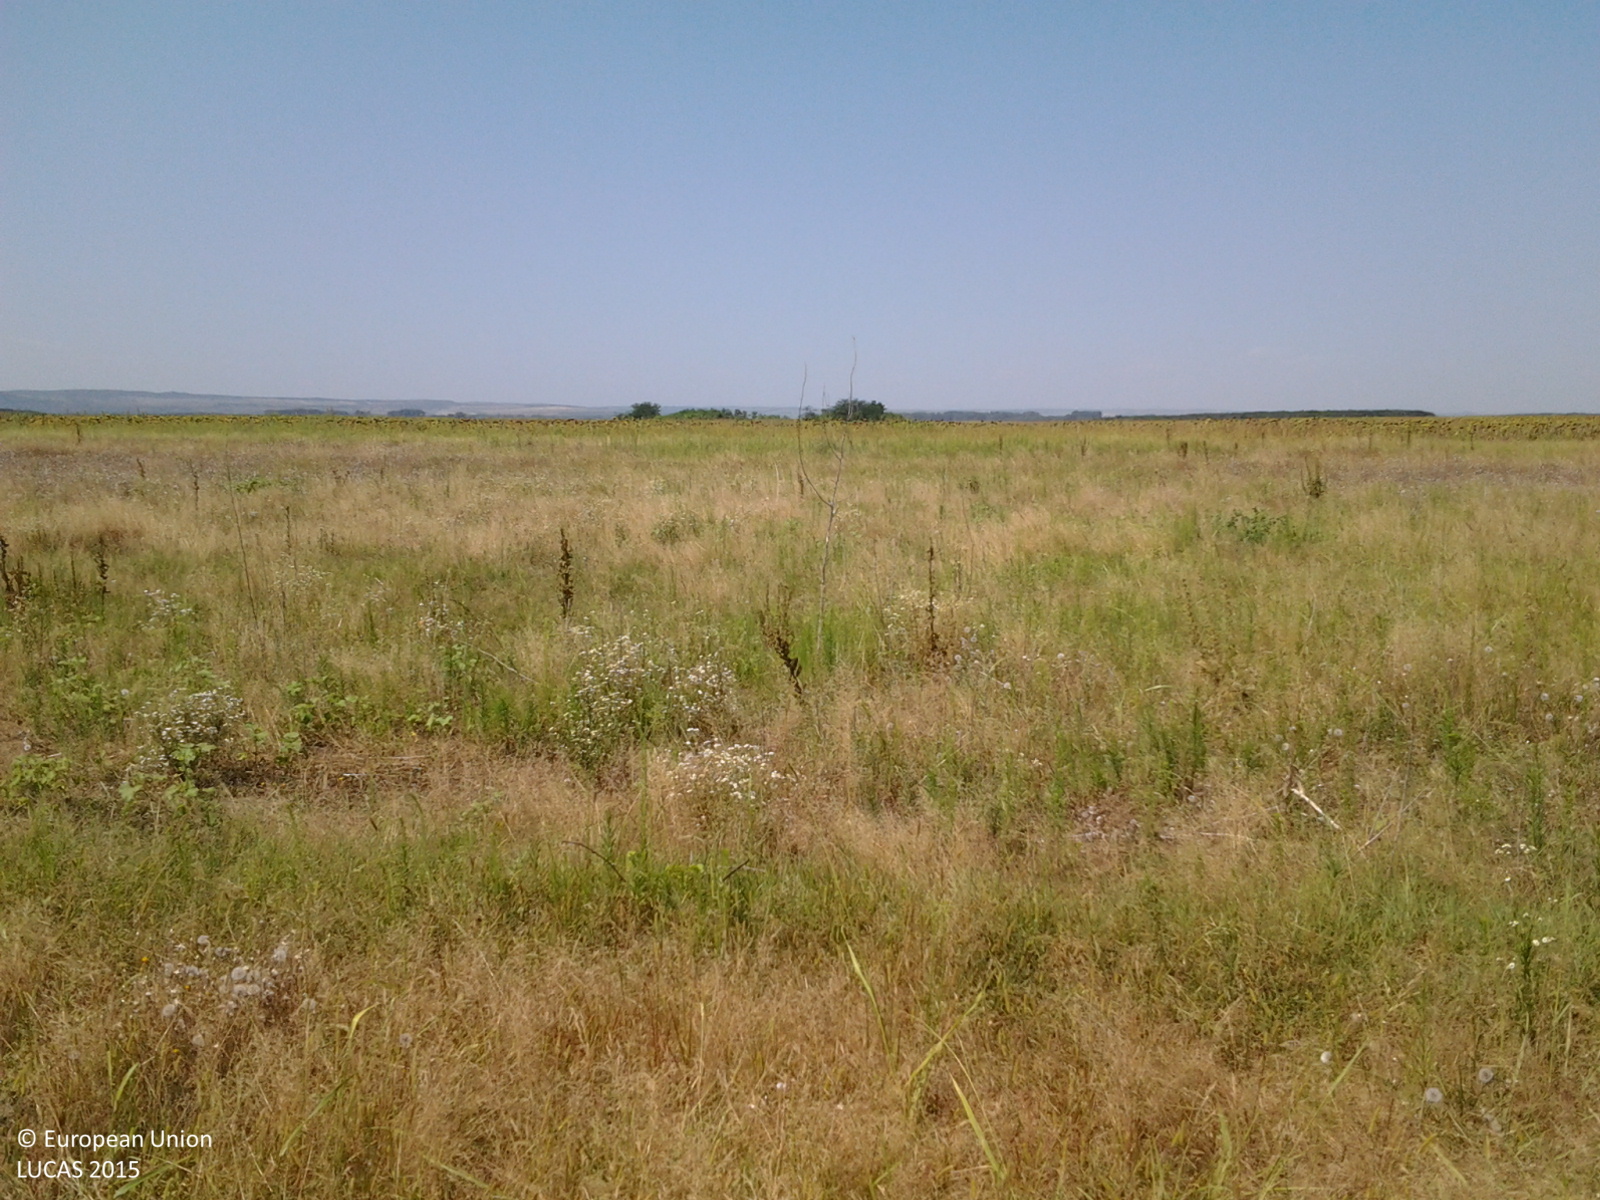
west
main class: Grassland
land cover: Grassland without tree/shrub cover
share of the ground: > 75 %
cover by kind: herbaceous plants 100 %
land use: Agriculture (excluding fallow land and kitchen gardens)
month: August
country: RO
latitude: 43.8824
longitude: 22.9465
